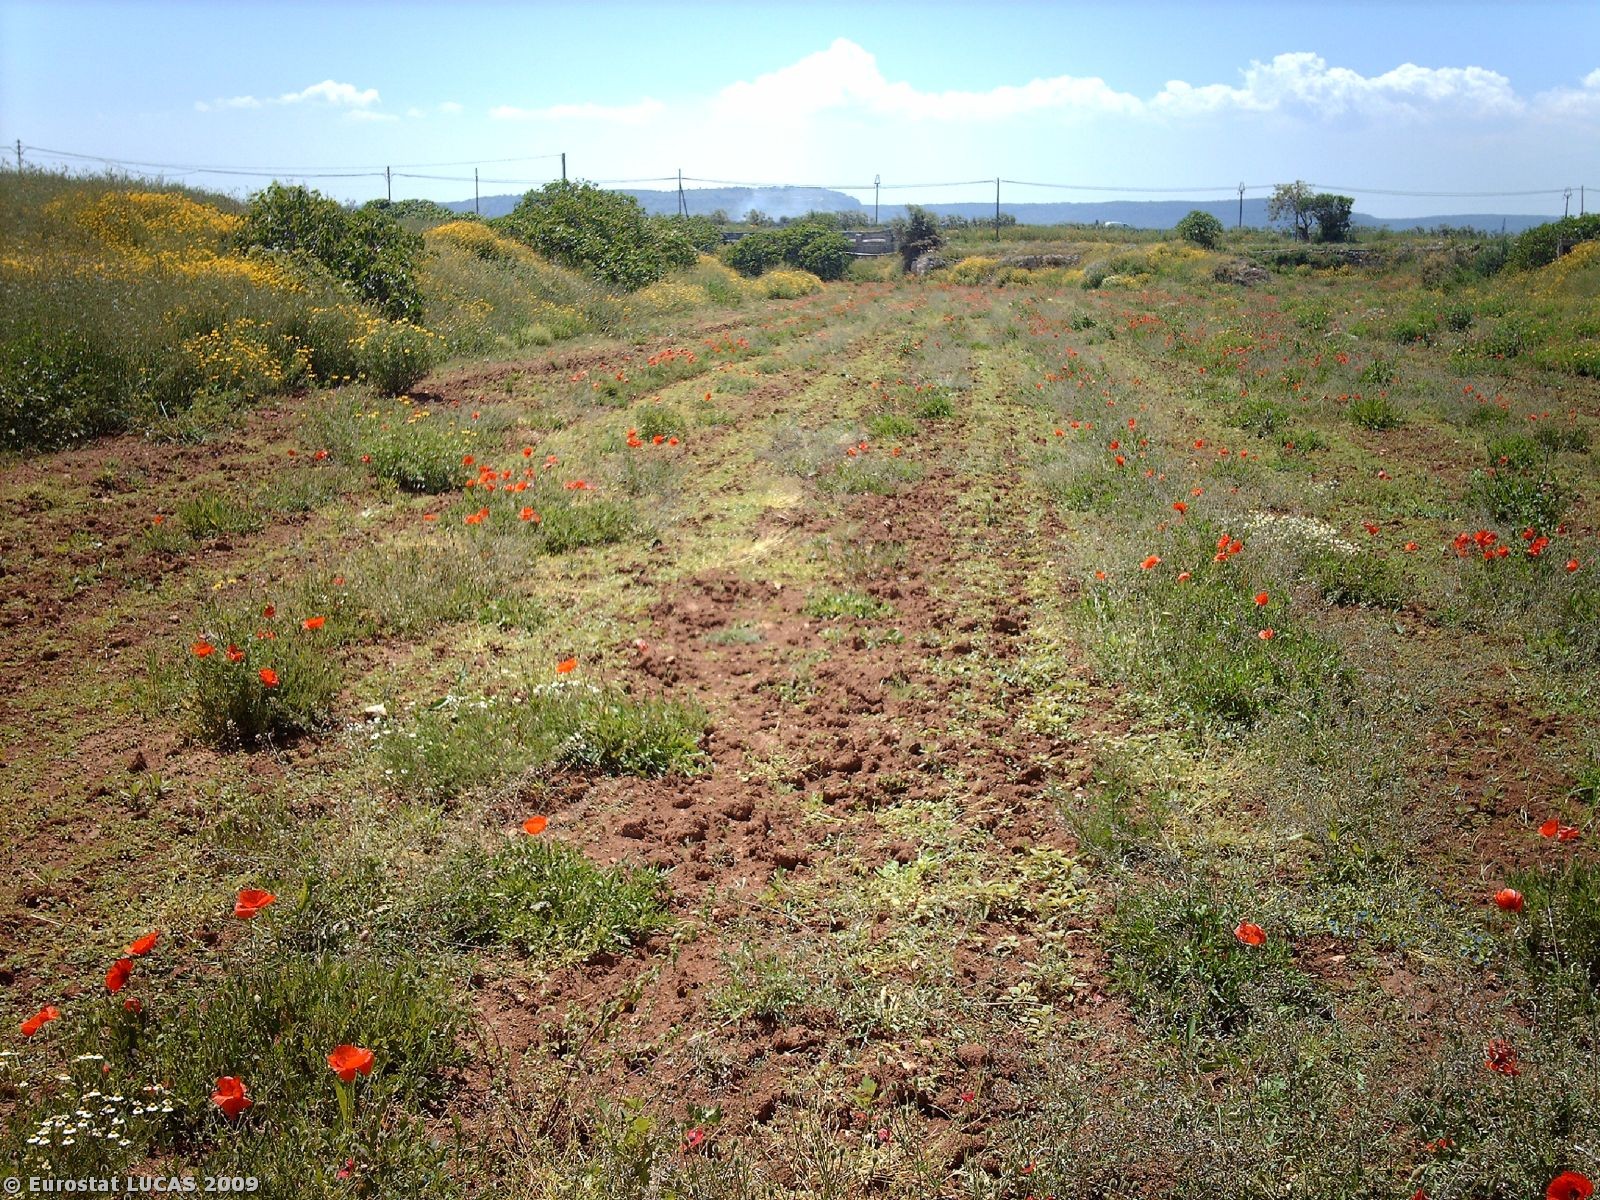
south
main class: Grassland
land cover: Spontaneously vegetated surfaces
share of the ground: > 75 %
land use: Fallow land
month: May
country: IT
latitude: 40.7916
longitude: 17.5744
